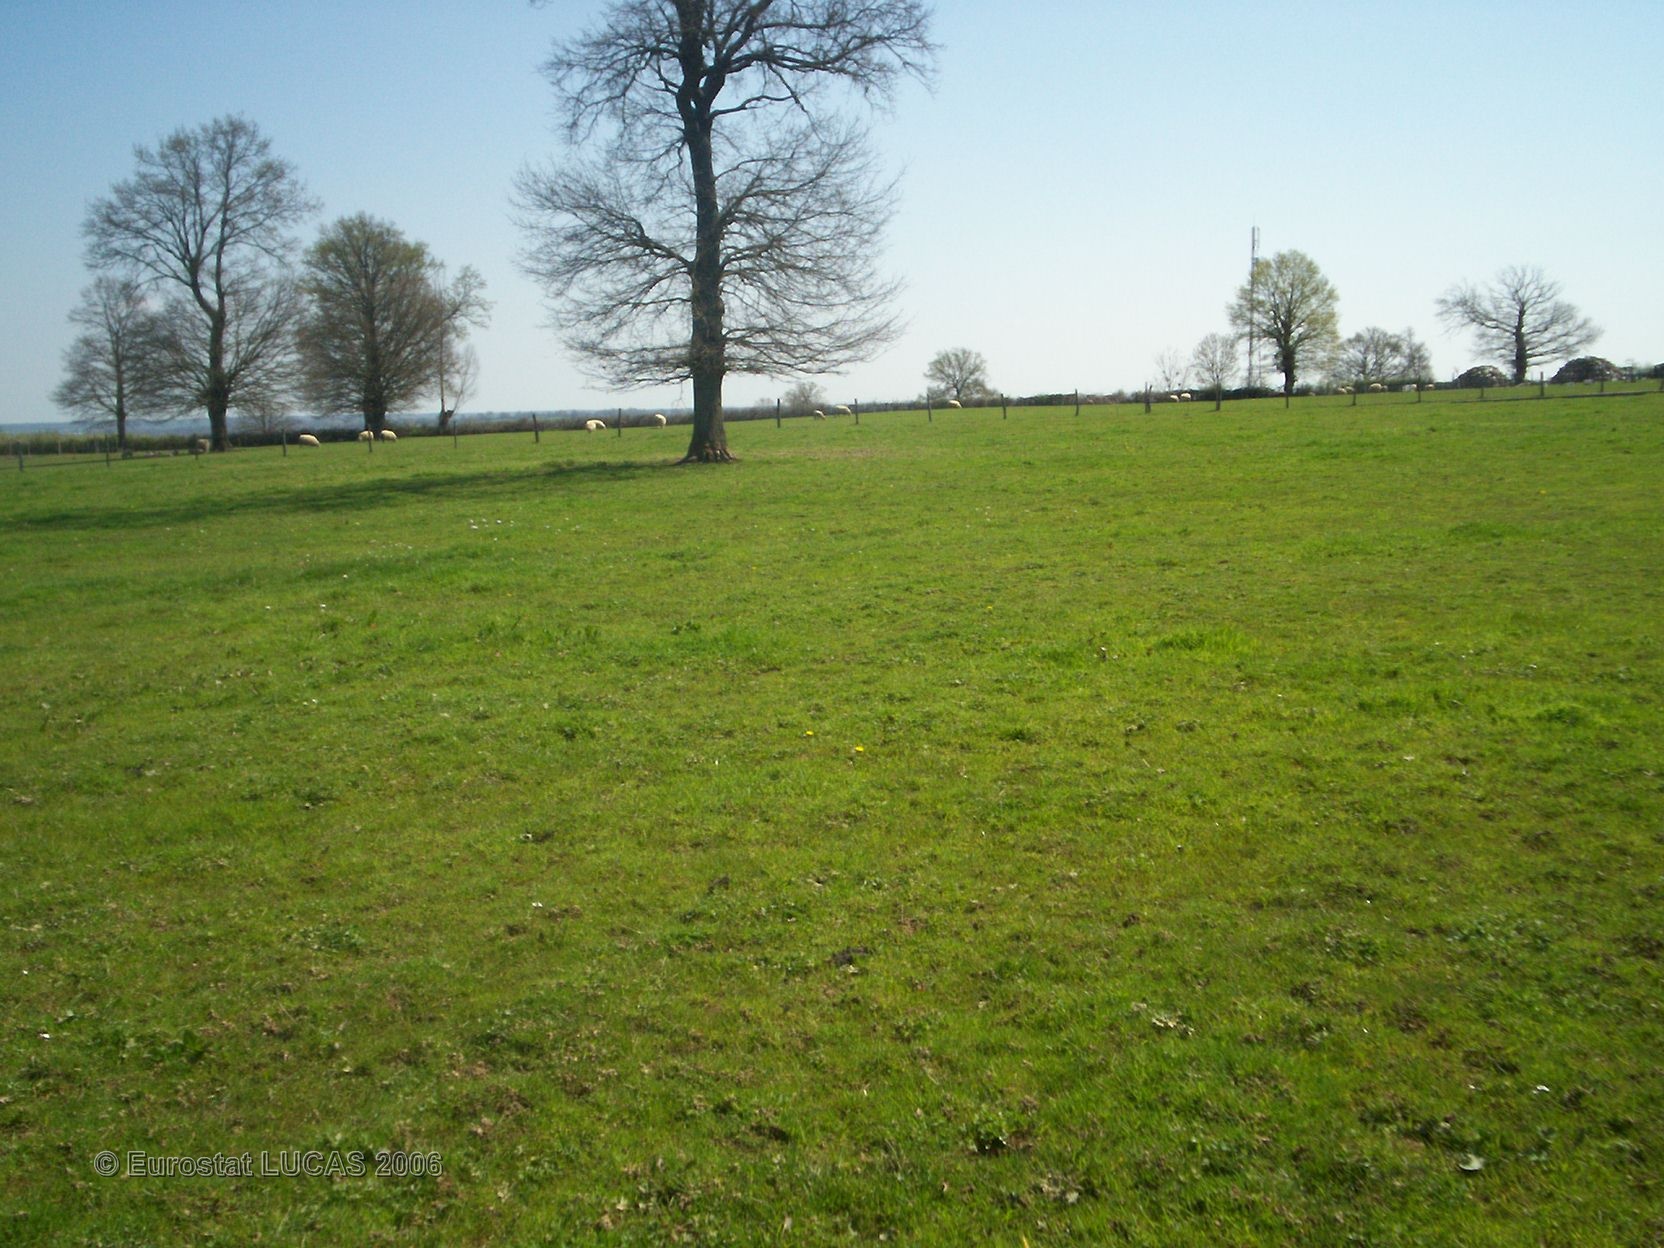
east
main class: Grassland
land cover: Grassland without tree/shrub cover
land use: Agriculture (excluding fallow land and kitchen gardens)
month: April
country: FR
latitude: 46.5960
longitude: 3.0658
